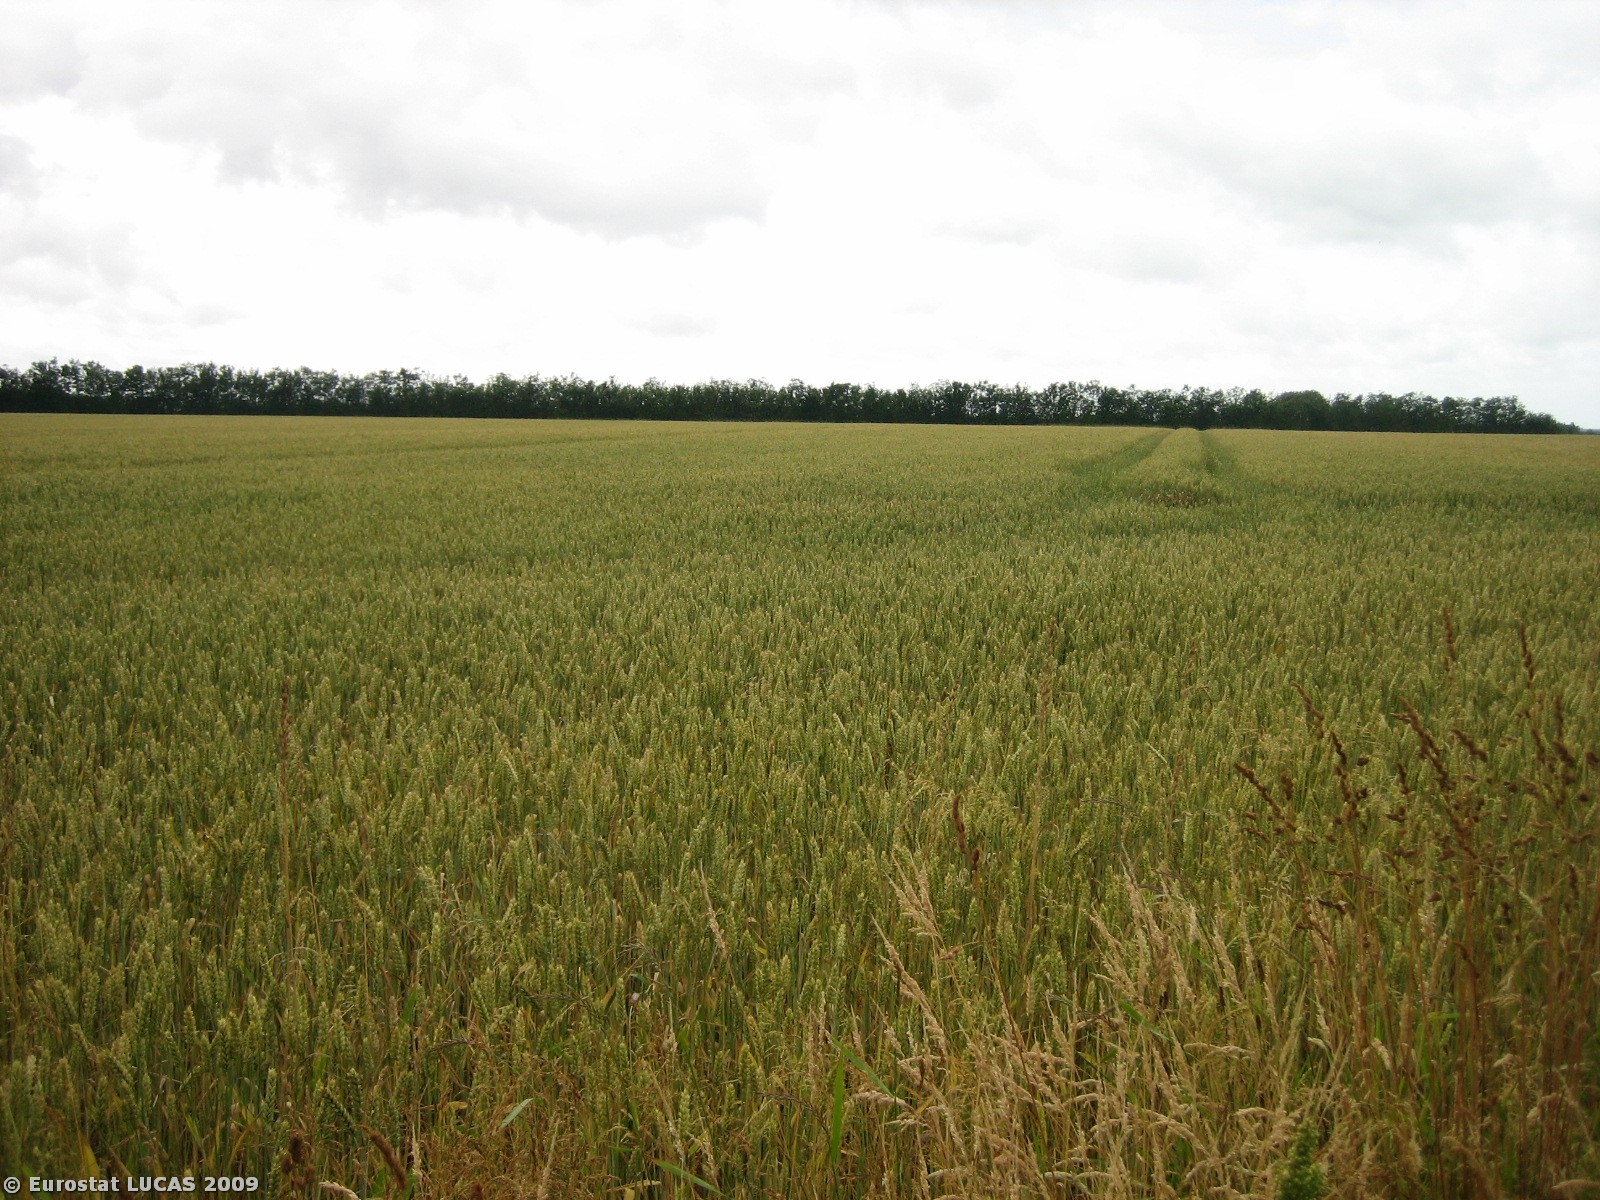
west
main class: Cropland
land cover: Common wheat
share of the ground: > 75 %
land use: Agriculture (excluding fallow land and kitchen gardens)
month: July
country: DK
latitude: 55.6380
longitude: 8.3652
